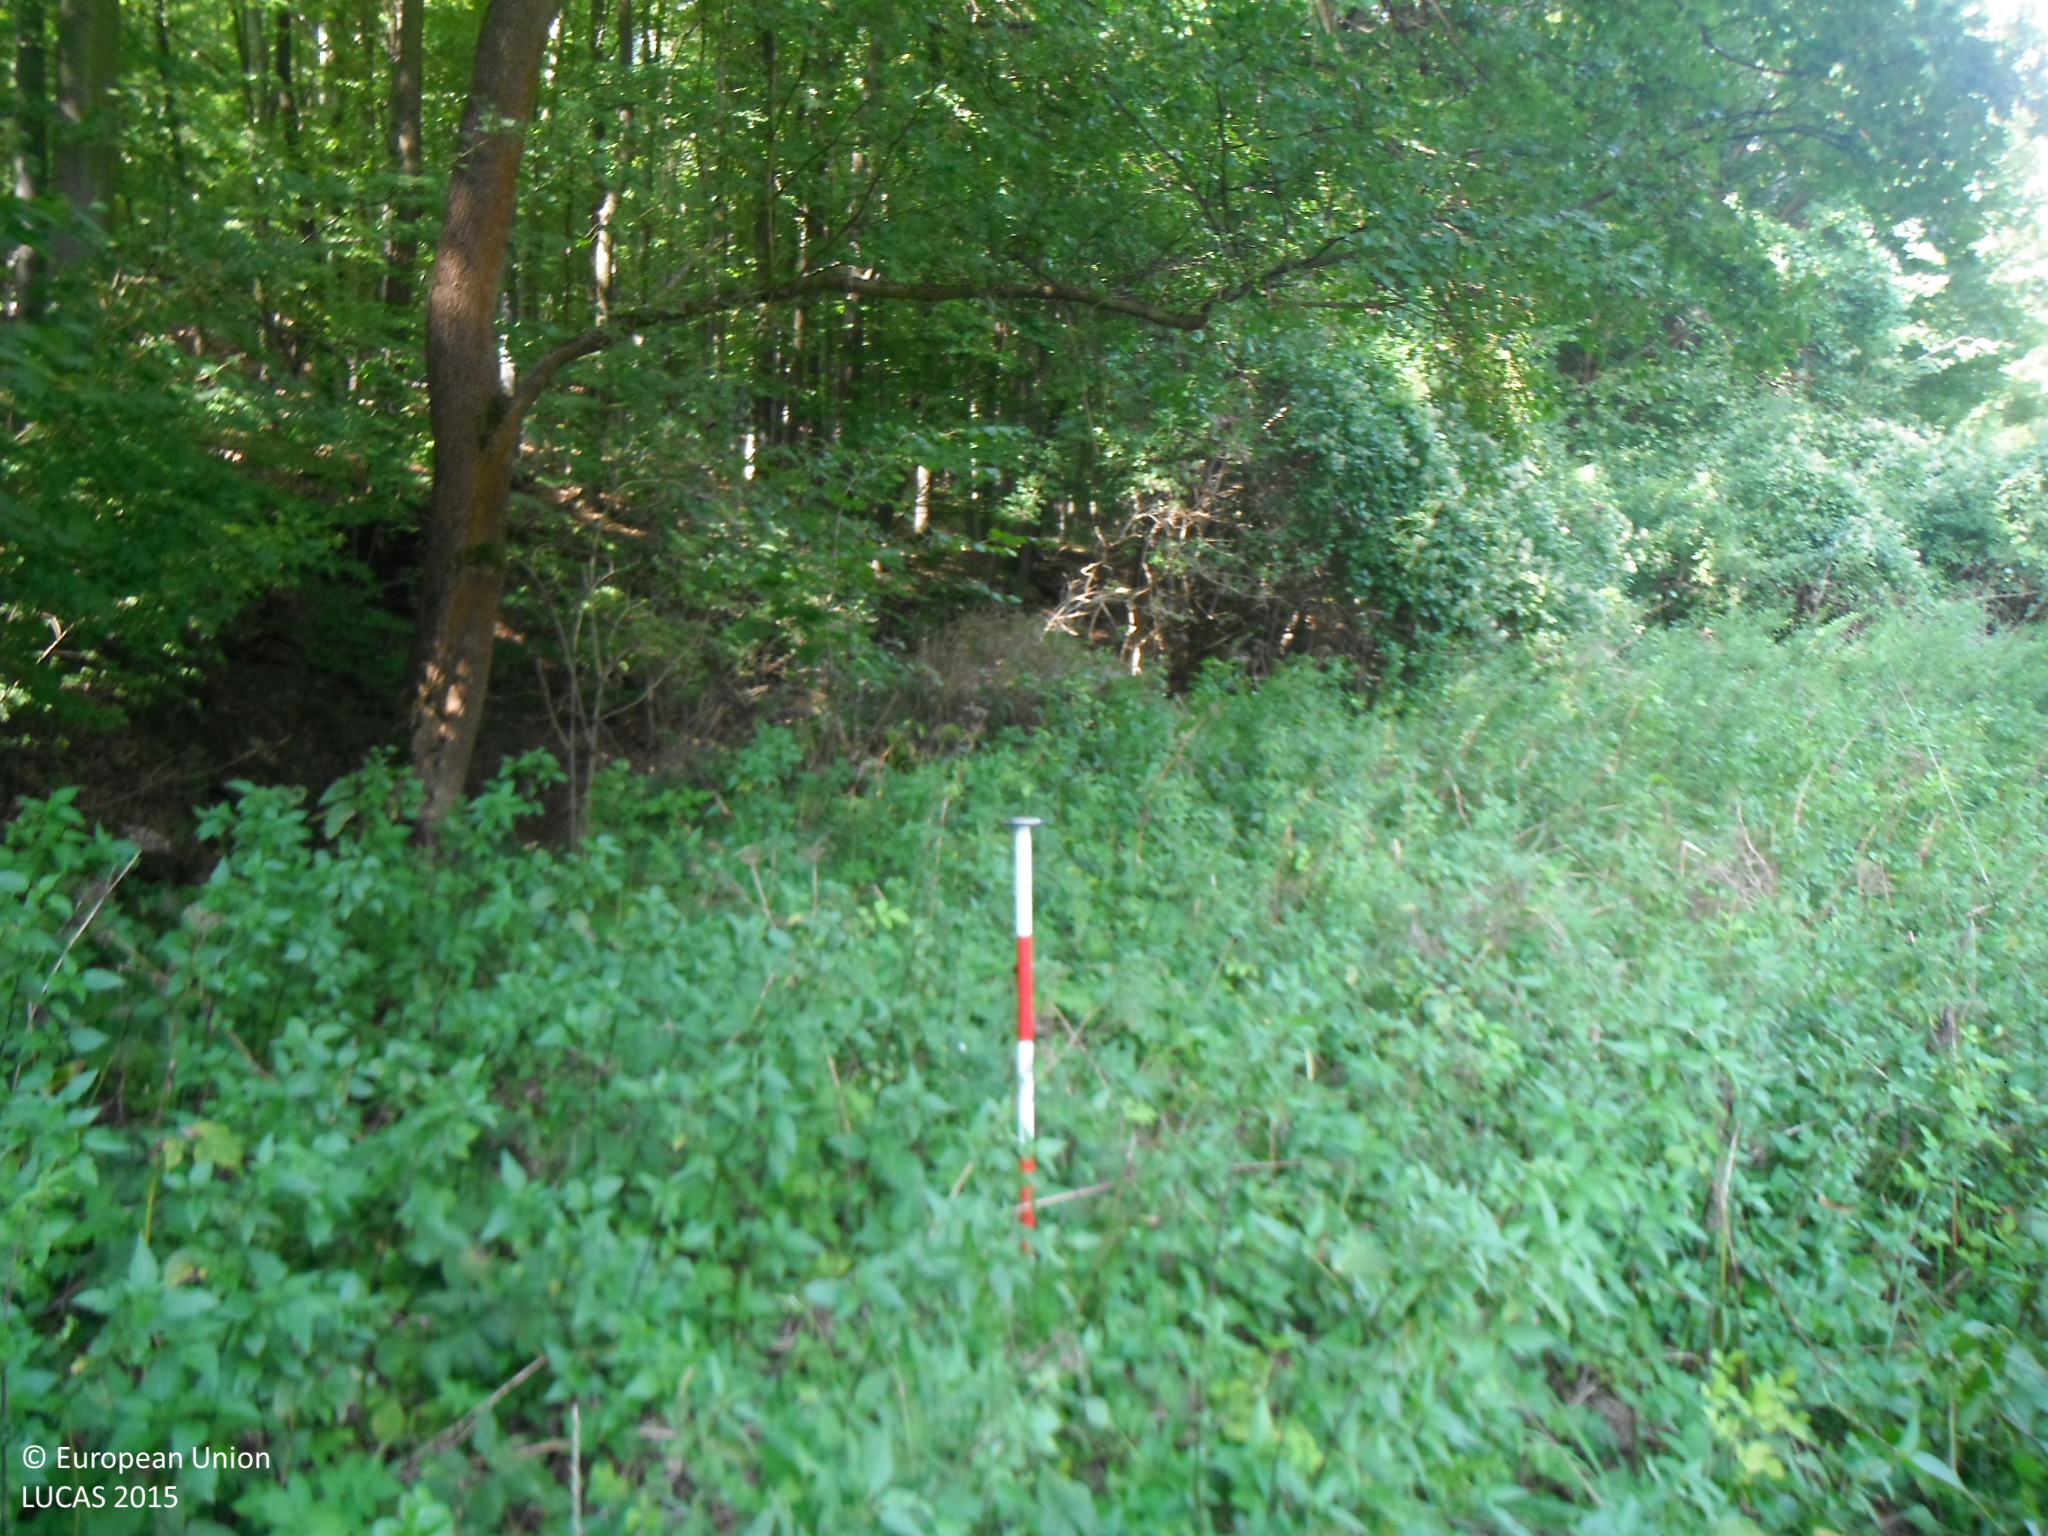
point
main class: Woodland
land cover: Broadleaved woodland
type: mesophytic deciduous forest
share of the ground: > 75 %
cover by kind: broadleaved forest trees 100 %
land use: Forestry
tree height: > 5 m
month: September
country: SK
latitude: 48.7464
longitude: 17.4772
